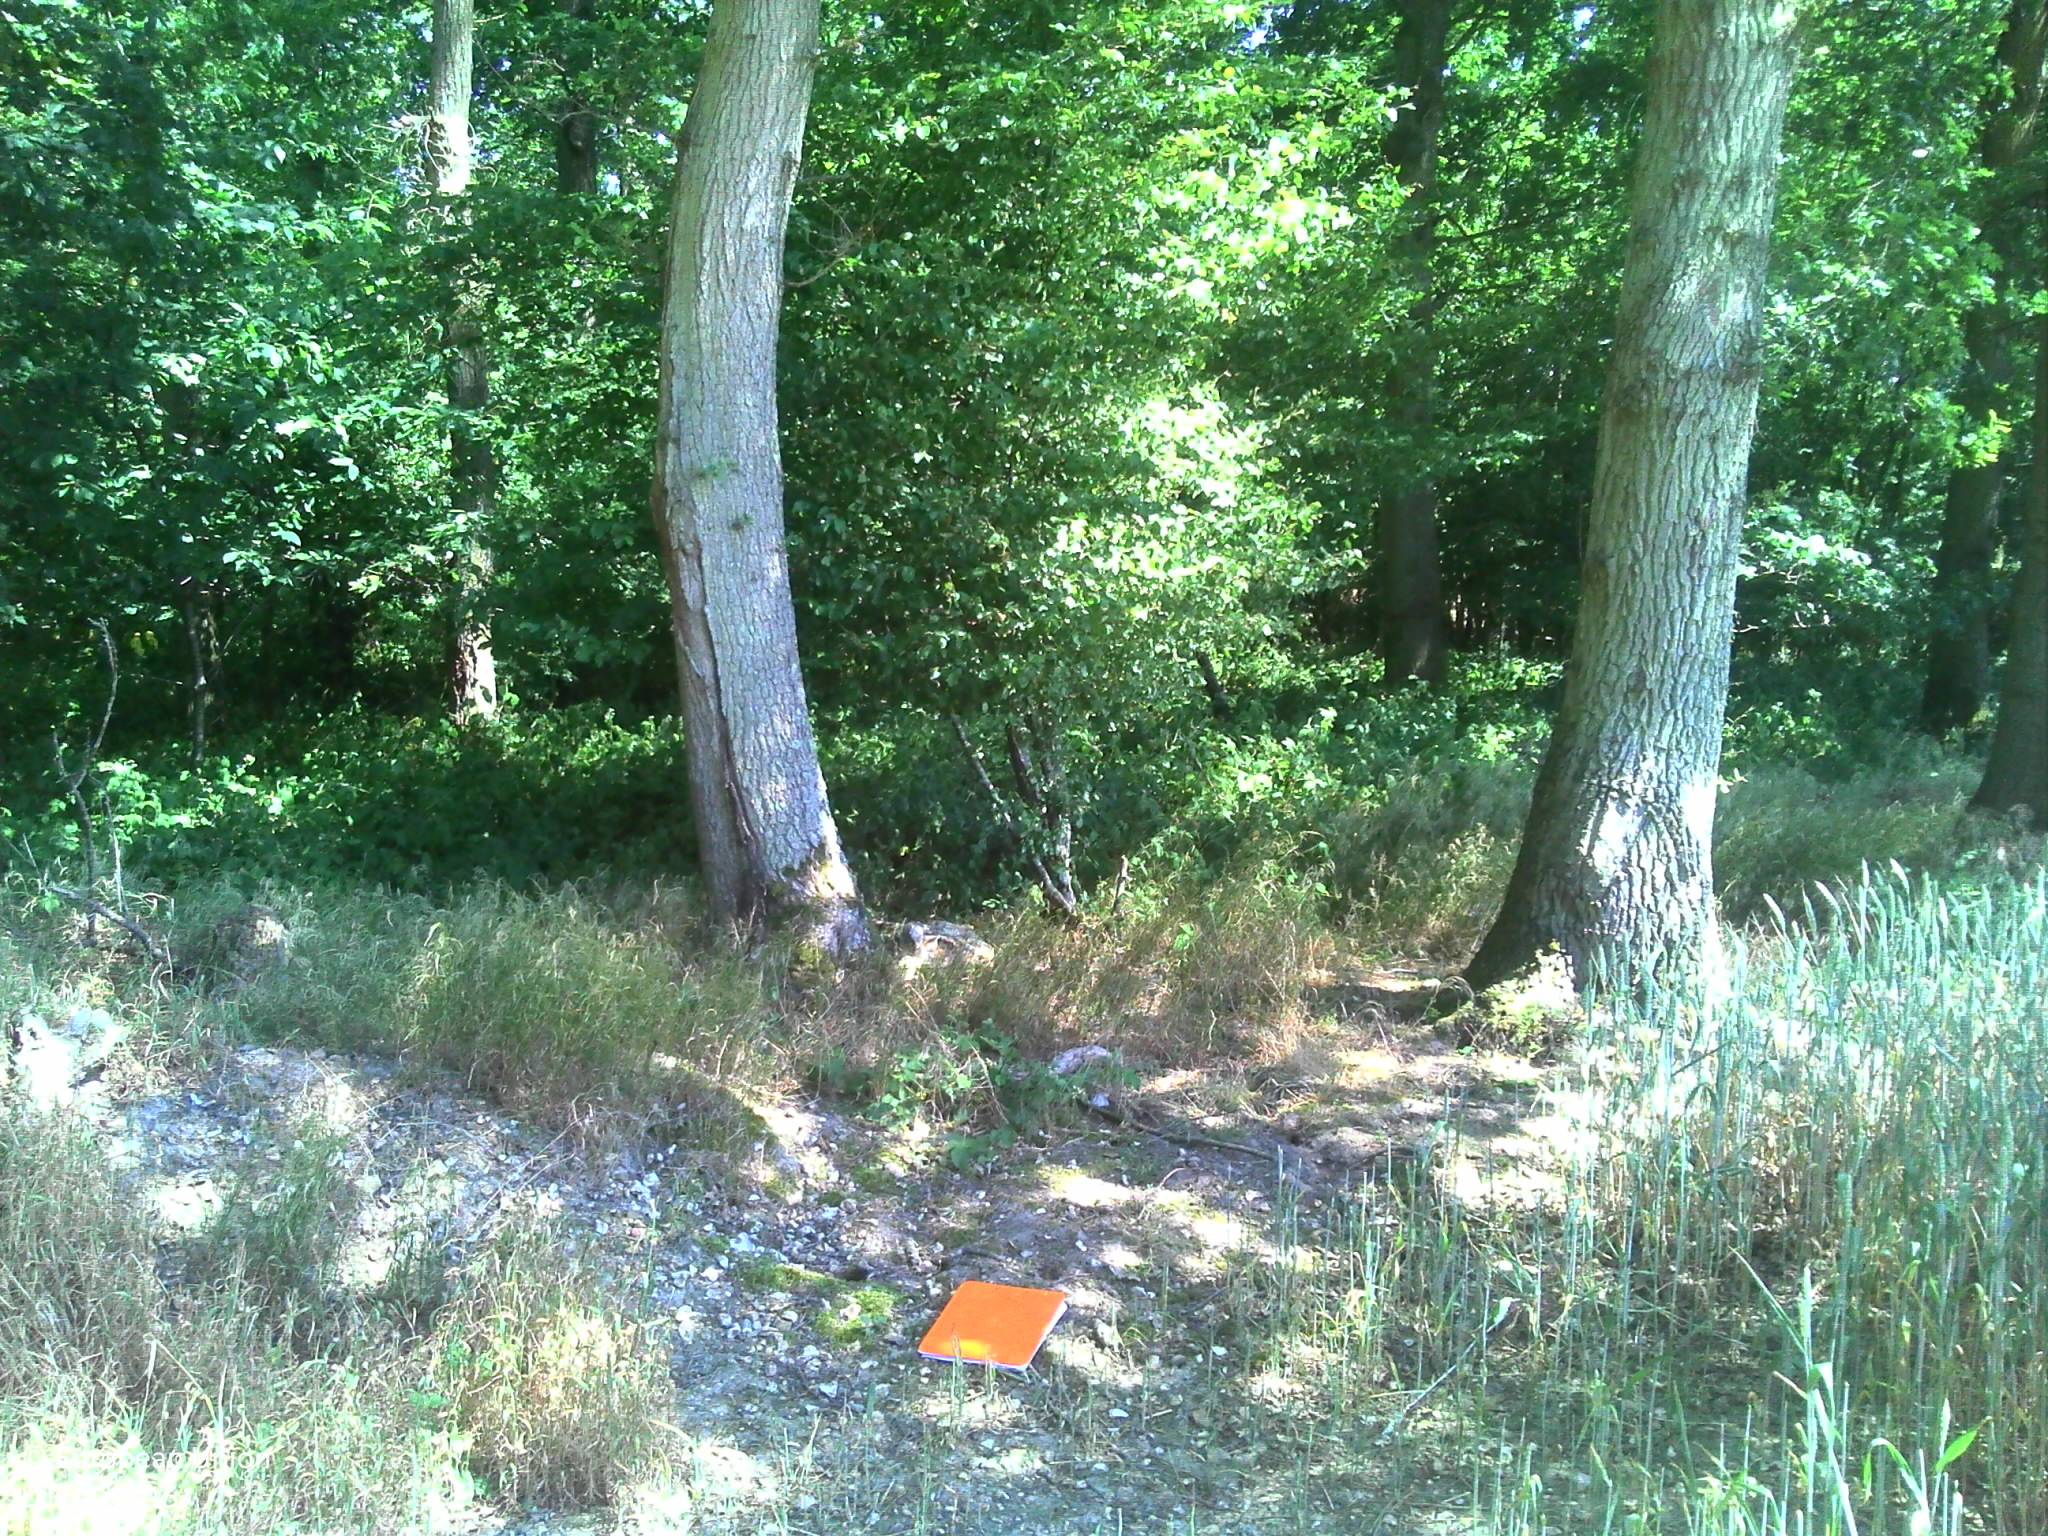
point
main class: Woodland
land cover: Broadleaved woodland
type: mesophytic deciduous forest
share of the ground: > 75 %
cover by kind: broadleaved forest trees 80 %, herbaceous plants 10 %, consolidated bare surface 10 %
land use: Forestry
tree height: > 5 m
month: June
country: FR
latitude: 48.9925
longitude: 1.1922
